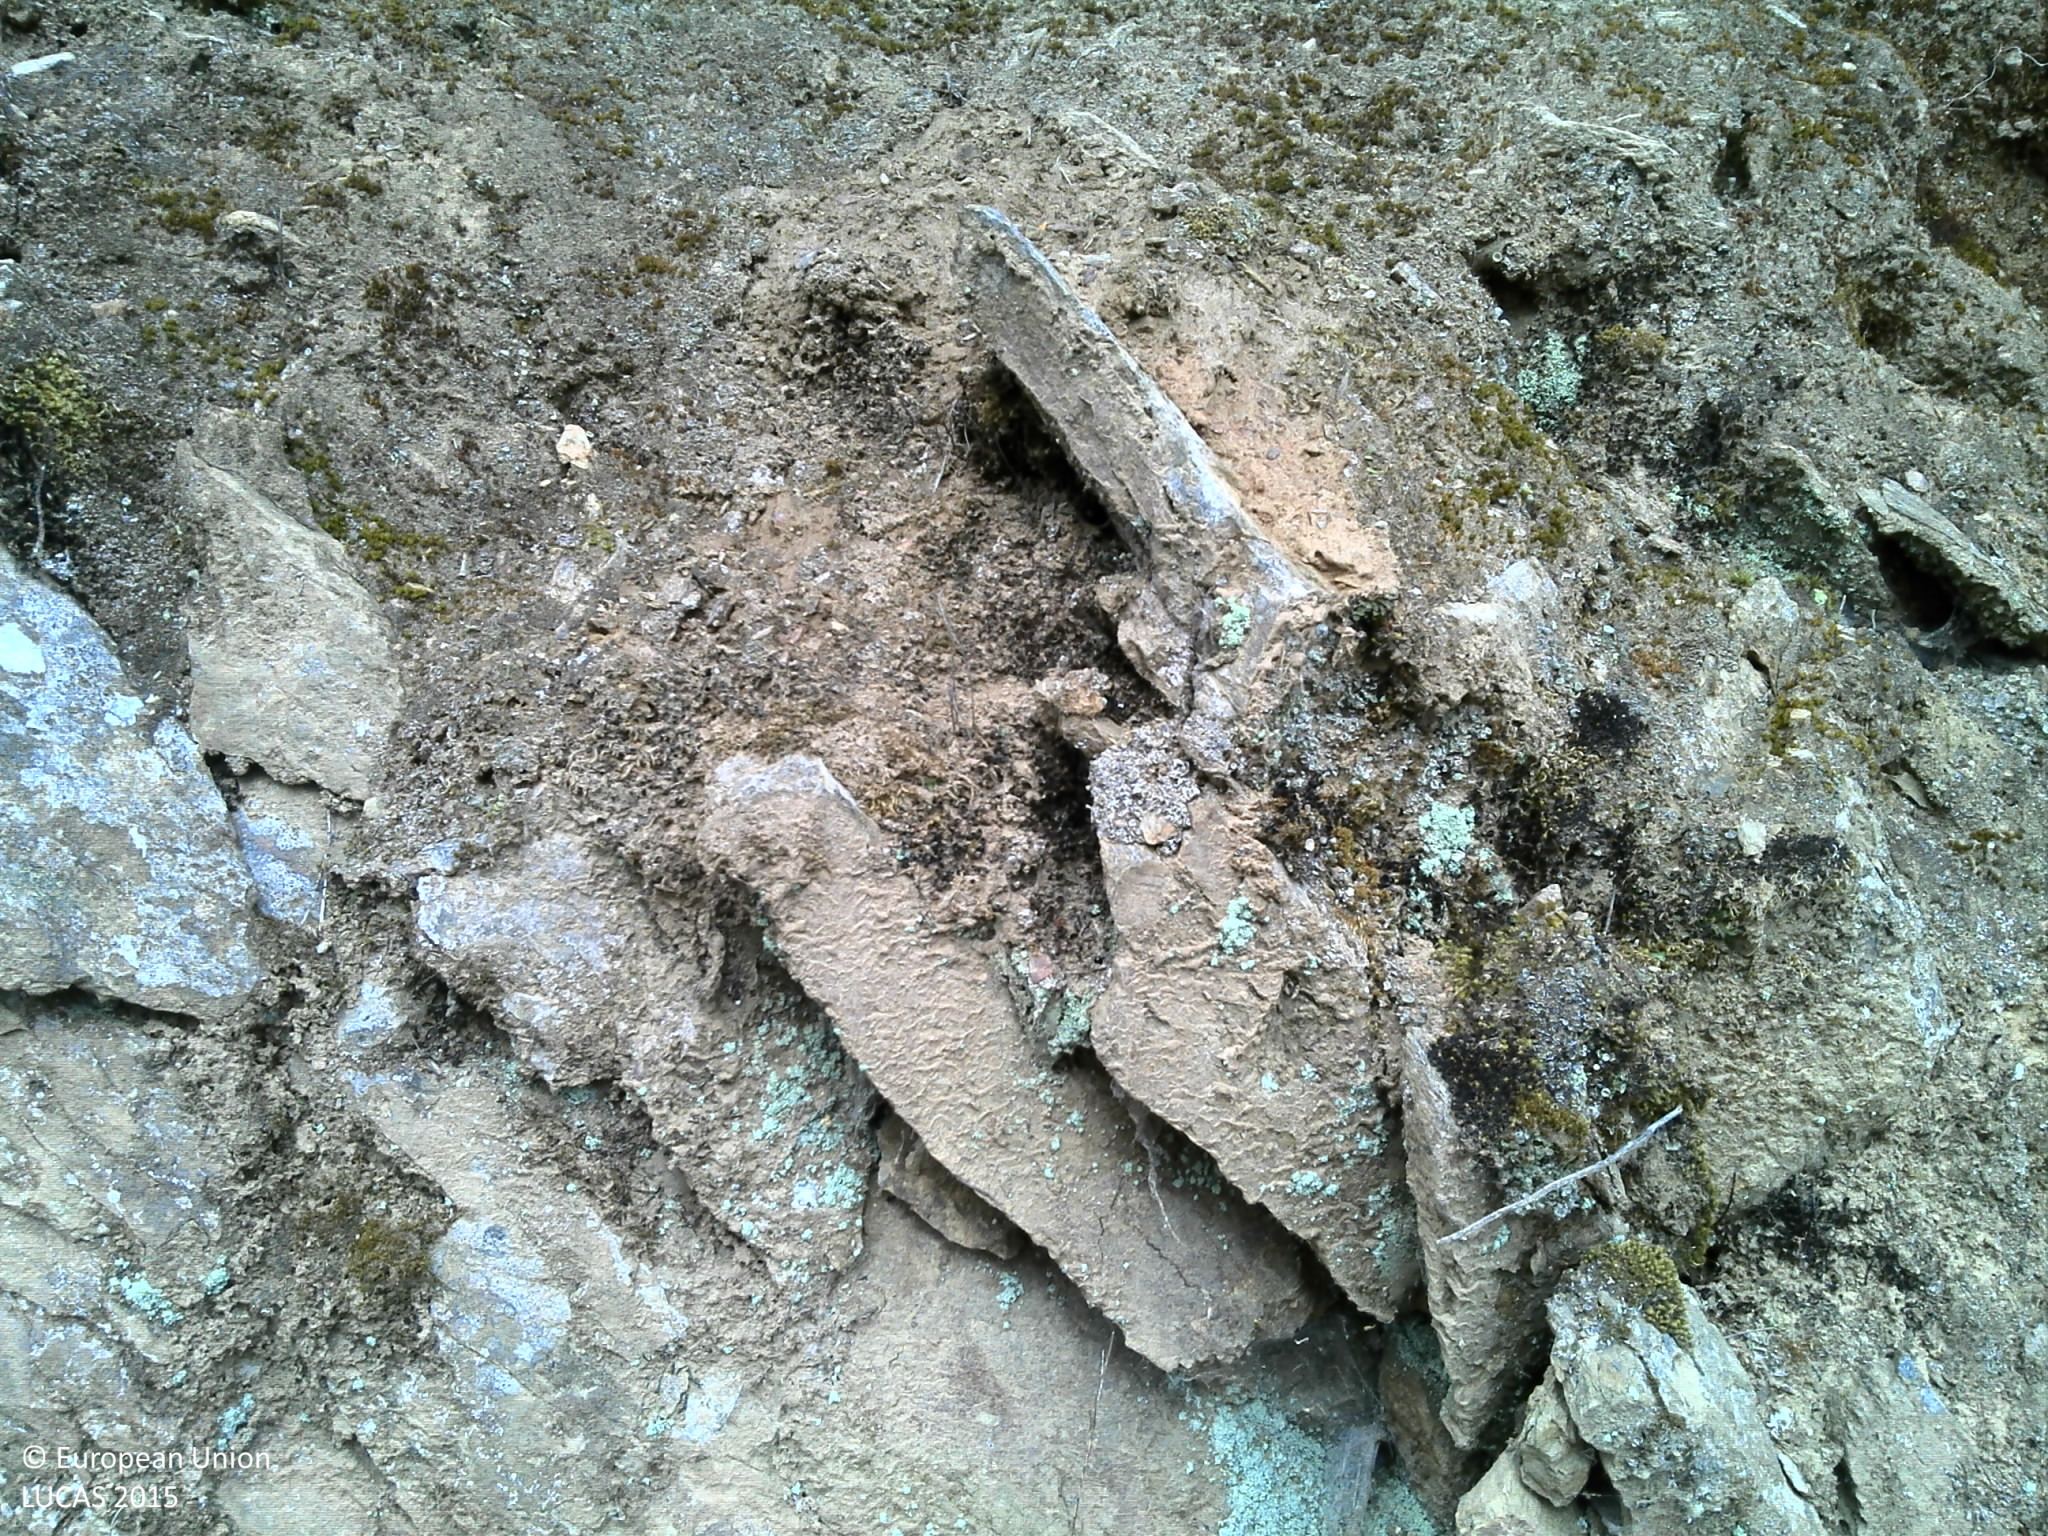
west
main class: Cropland
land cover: Olive groves
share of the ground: < 10 %
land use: Agriculture (excluding fallow land and kitchen gardens)
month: June
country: PT
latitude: 41.1220
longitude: -7.5719
